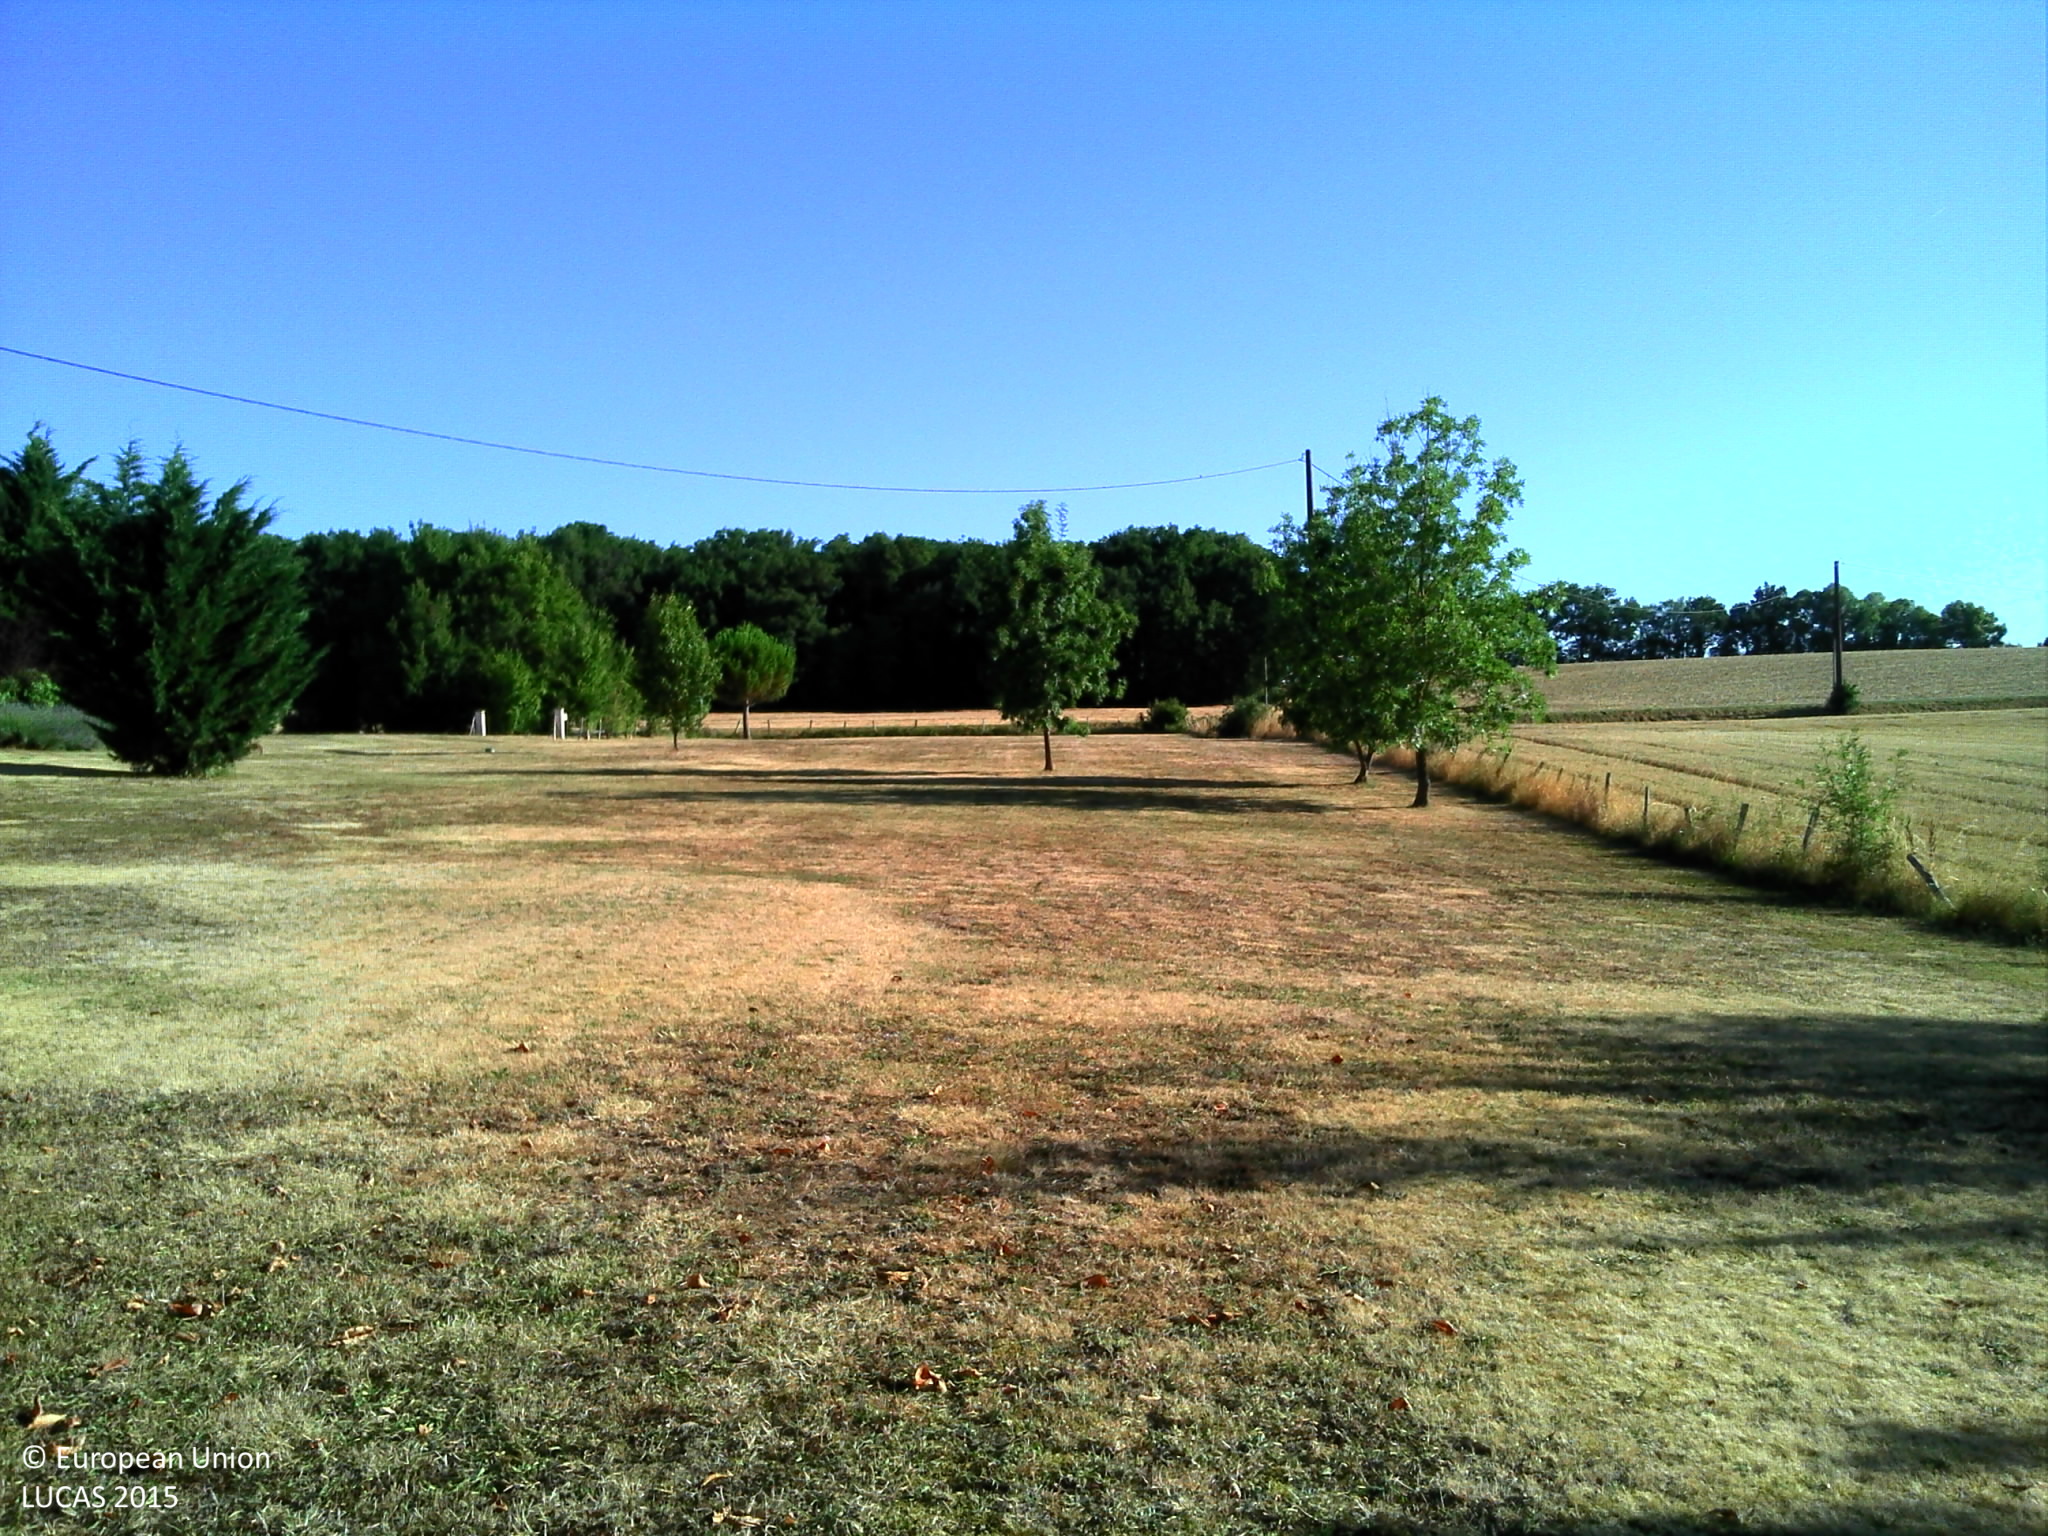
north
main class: Cropland
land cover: Cherry fruit
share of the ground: 25 - 50 %
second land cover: Grassland without tree/shrub cover
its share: > 75 %
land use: Kitchen garden
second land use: Residential
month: July
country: FR
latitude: 44.7358
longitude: 0.5582
